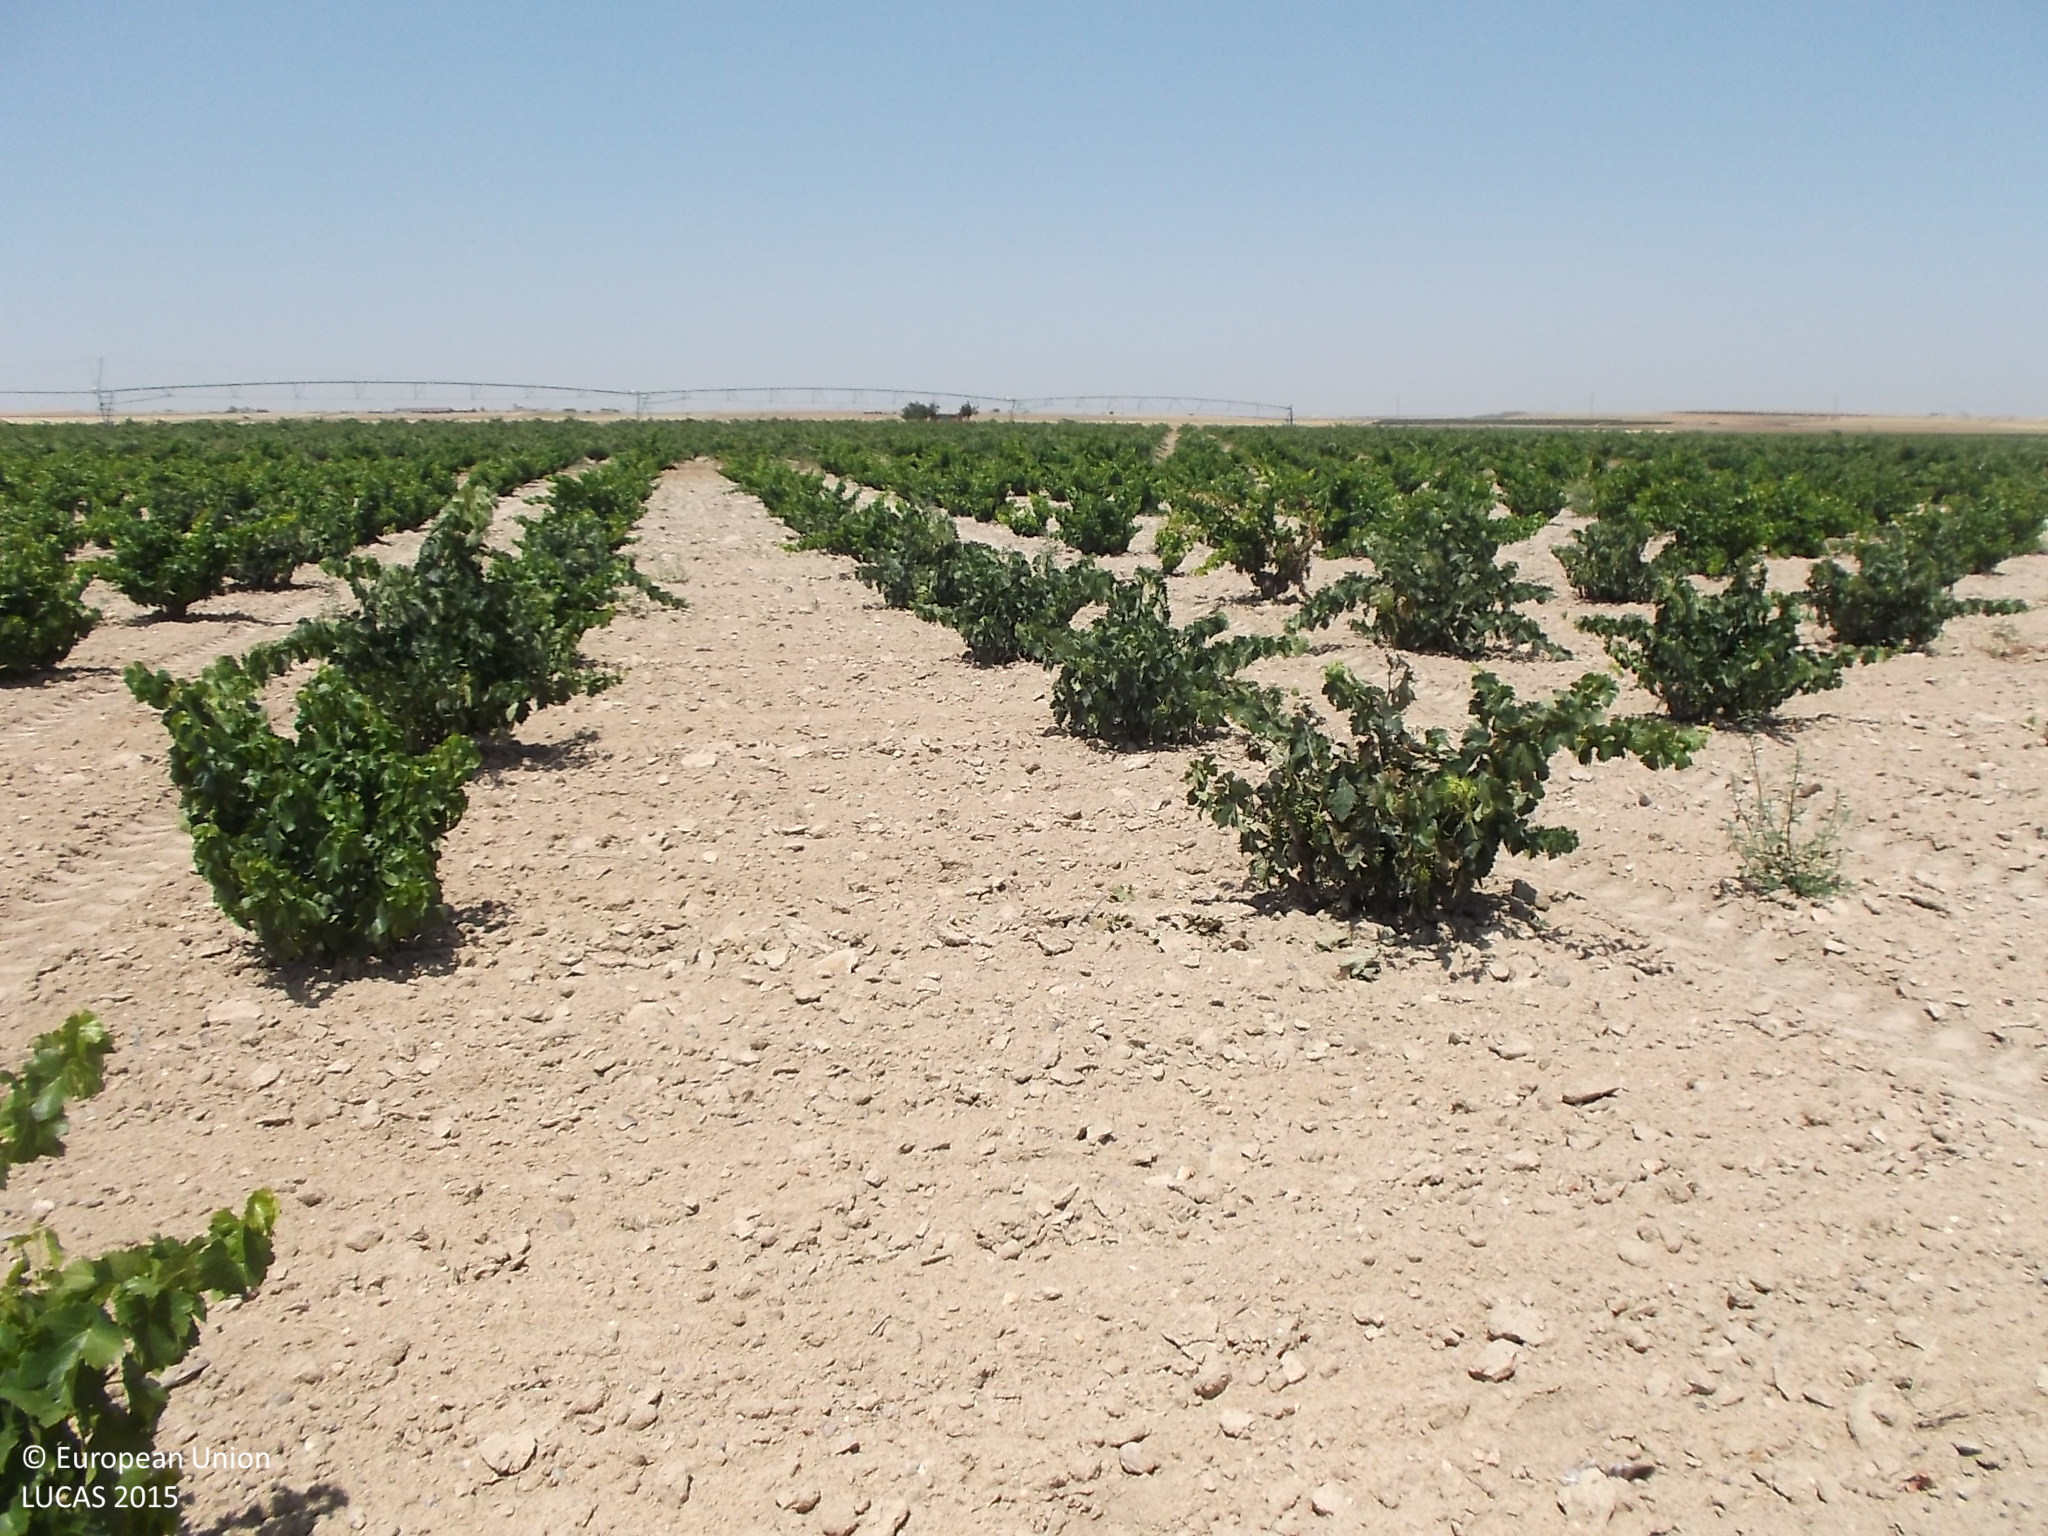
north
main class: Cropland
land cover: Vineyards
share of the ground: 10 - 25 %
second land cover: Other bare soil
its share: > 75 %
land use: Agriculture (excluding fallow land and kitchen gardens)
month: July
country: ES
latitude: 41.5544
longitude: -5.3173
